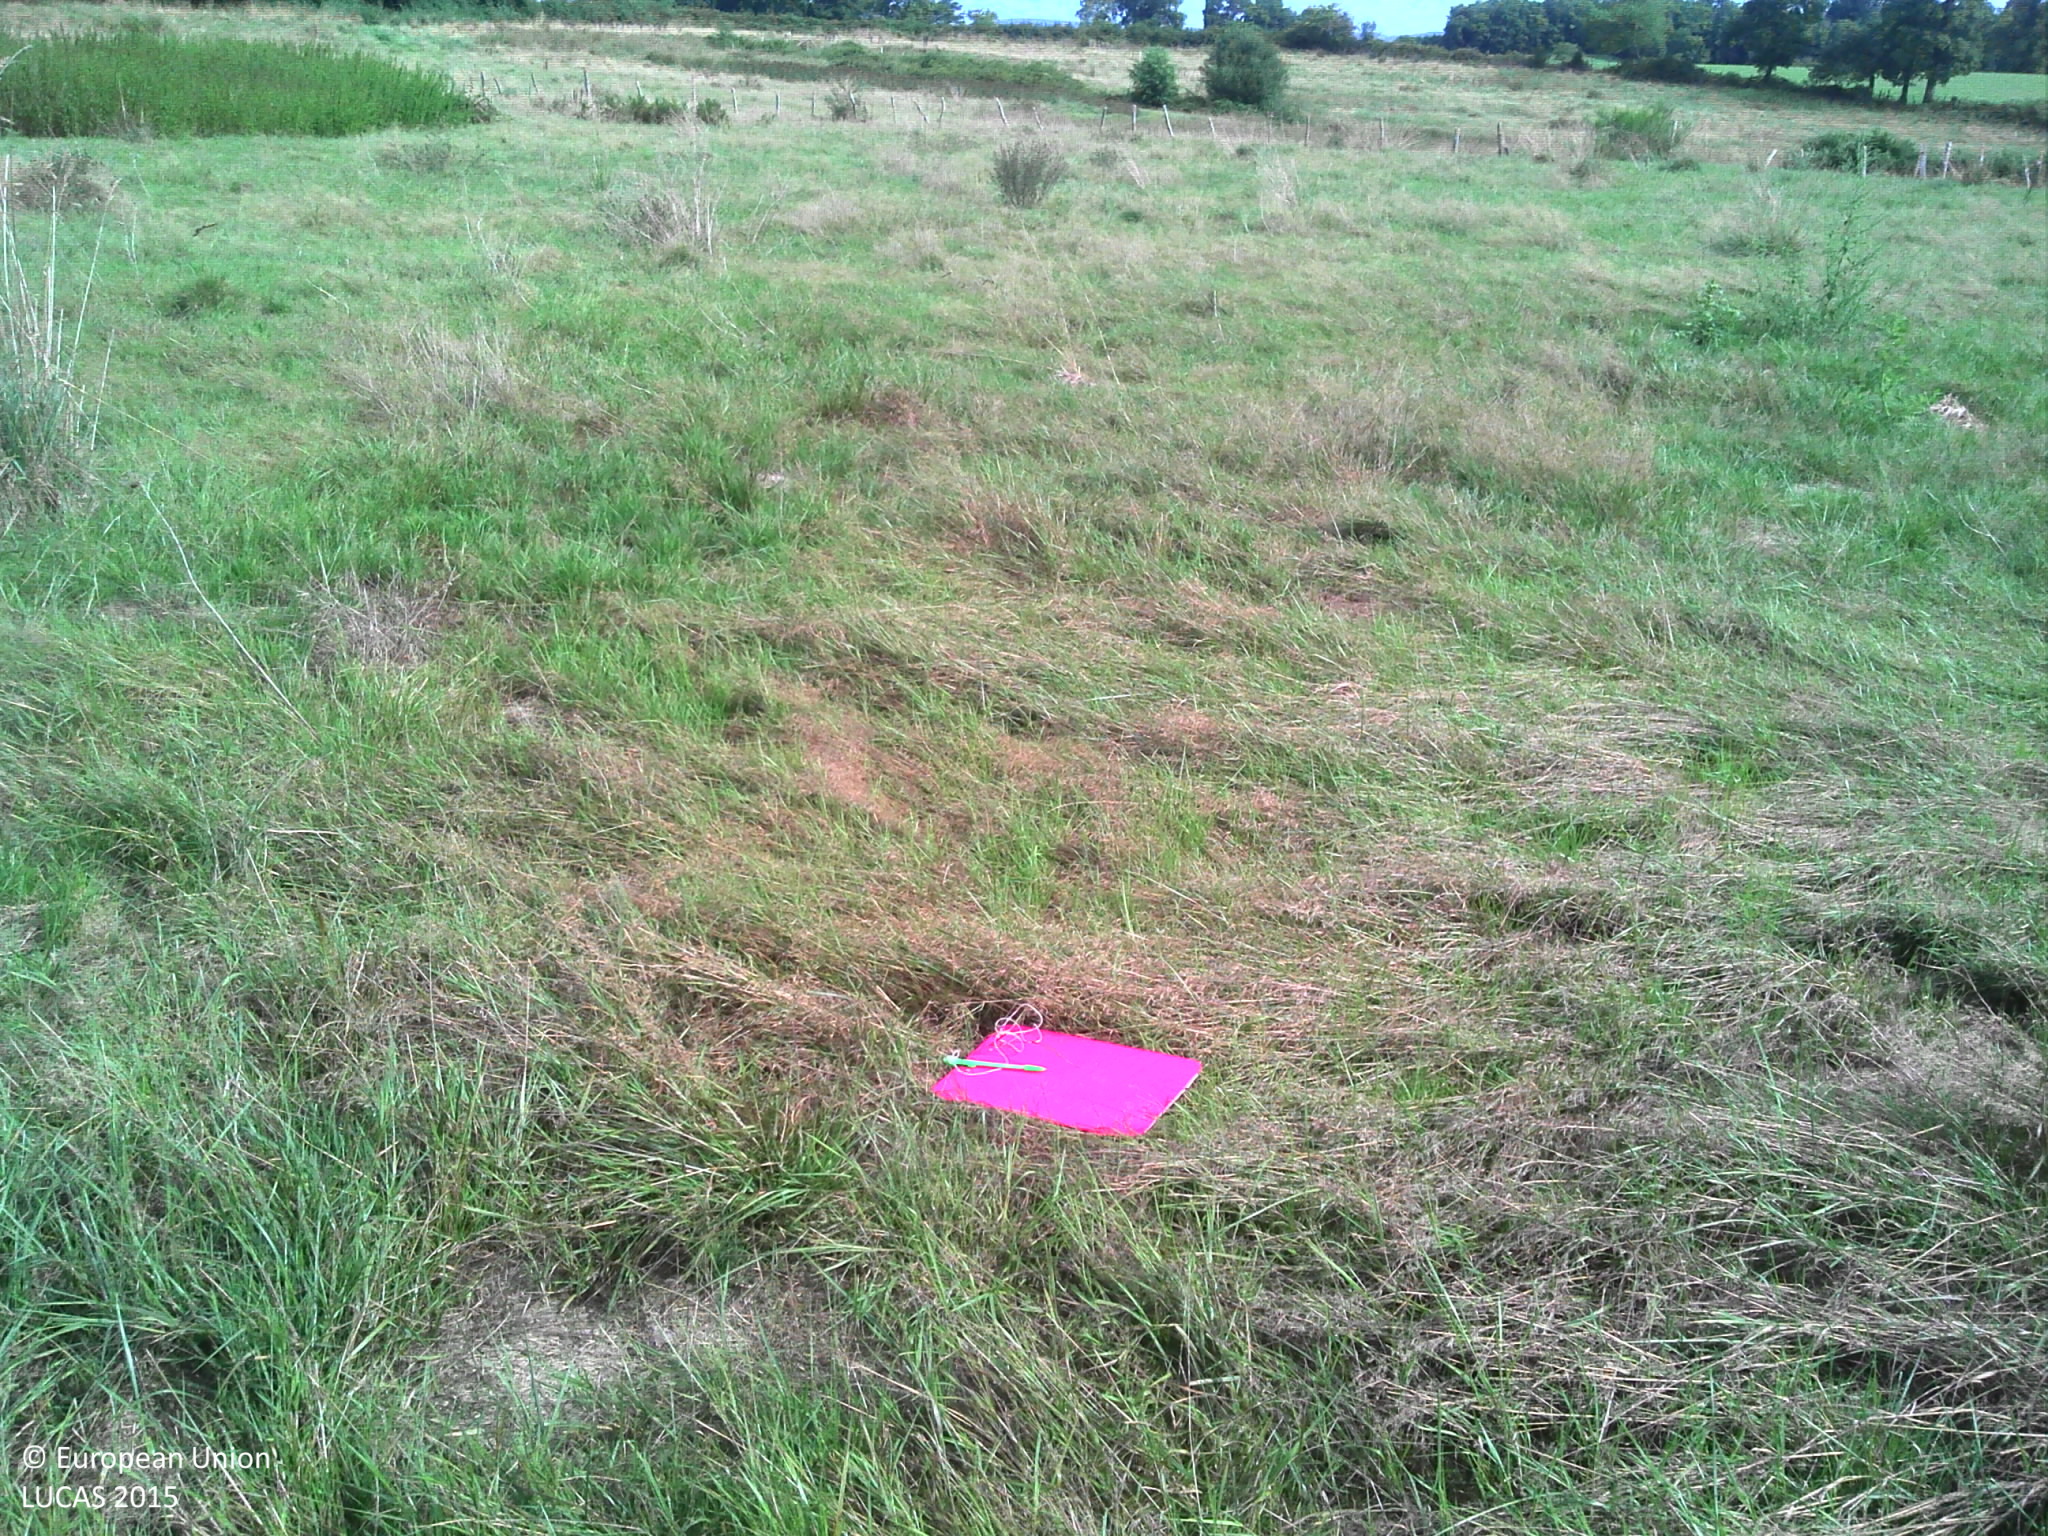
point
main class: Grassland
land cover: Grassland without tree/shrub cover
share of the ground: > 75 %
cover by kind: herbaceous plants 95 %, shrubs 5 %
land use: Agriculture (excluding fallow land and kitchen gardens)
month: August
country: FR
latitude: 46.1708
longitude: 1.2204
